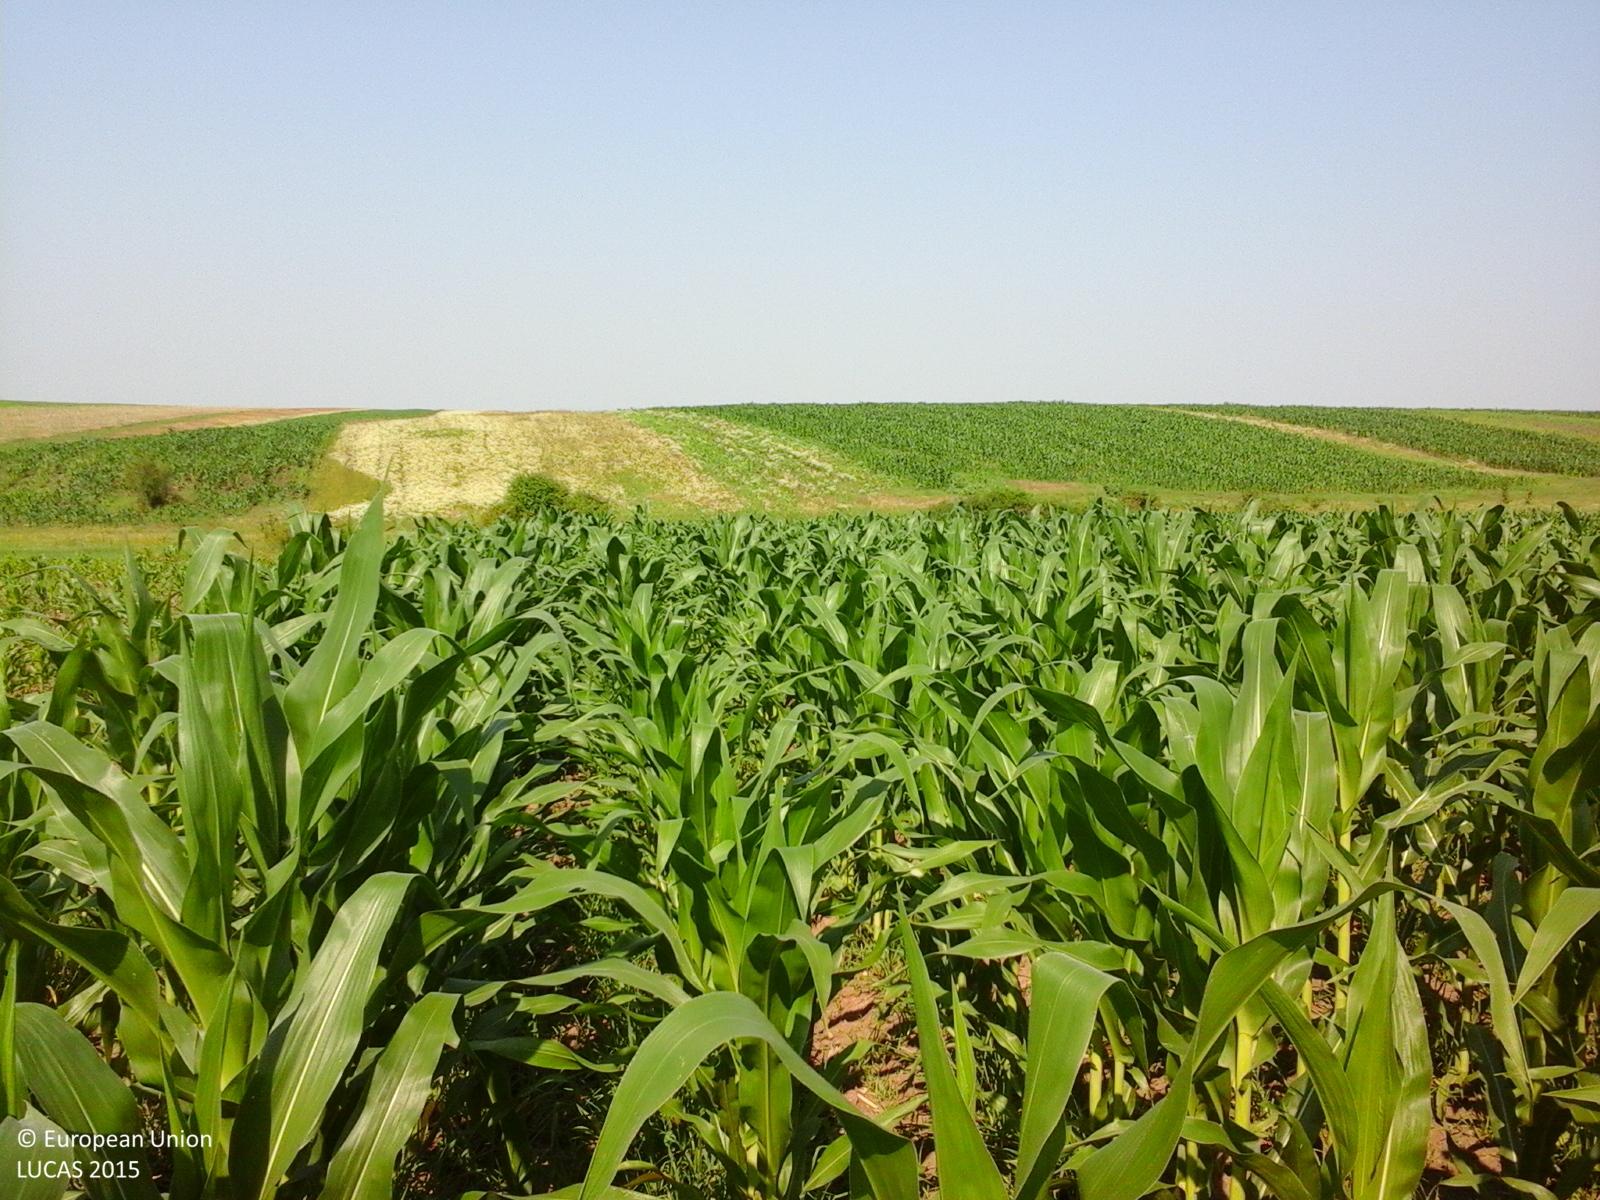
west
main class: Cropland
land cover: Maize
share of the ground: > 75 %
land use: Agriculture (excluding fallow land and kitchen gardens)
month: July
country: RO
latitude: 44.6493
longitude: 24.5873
